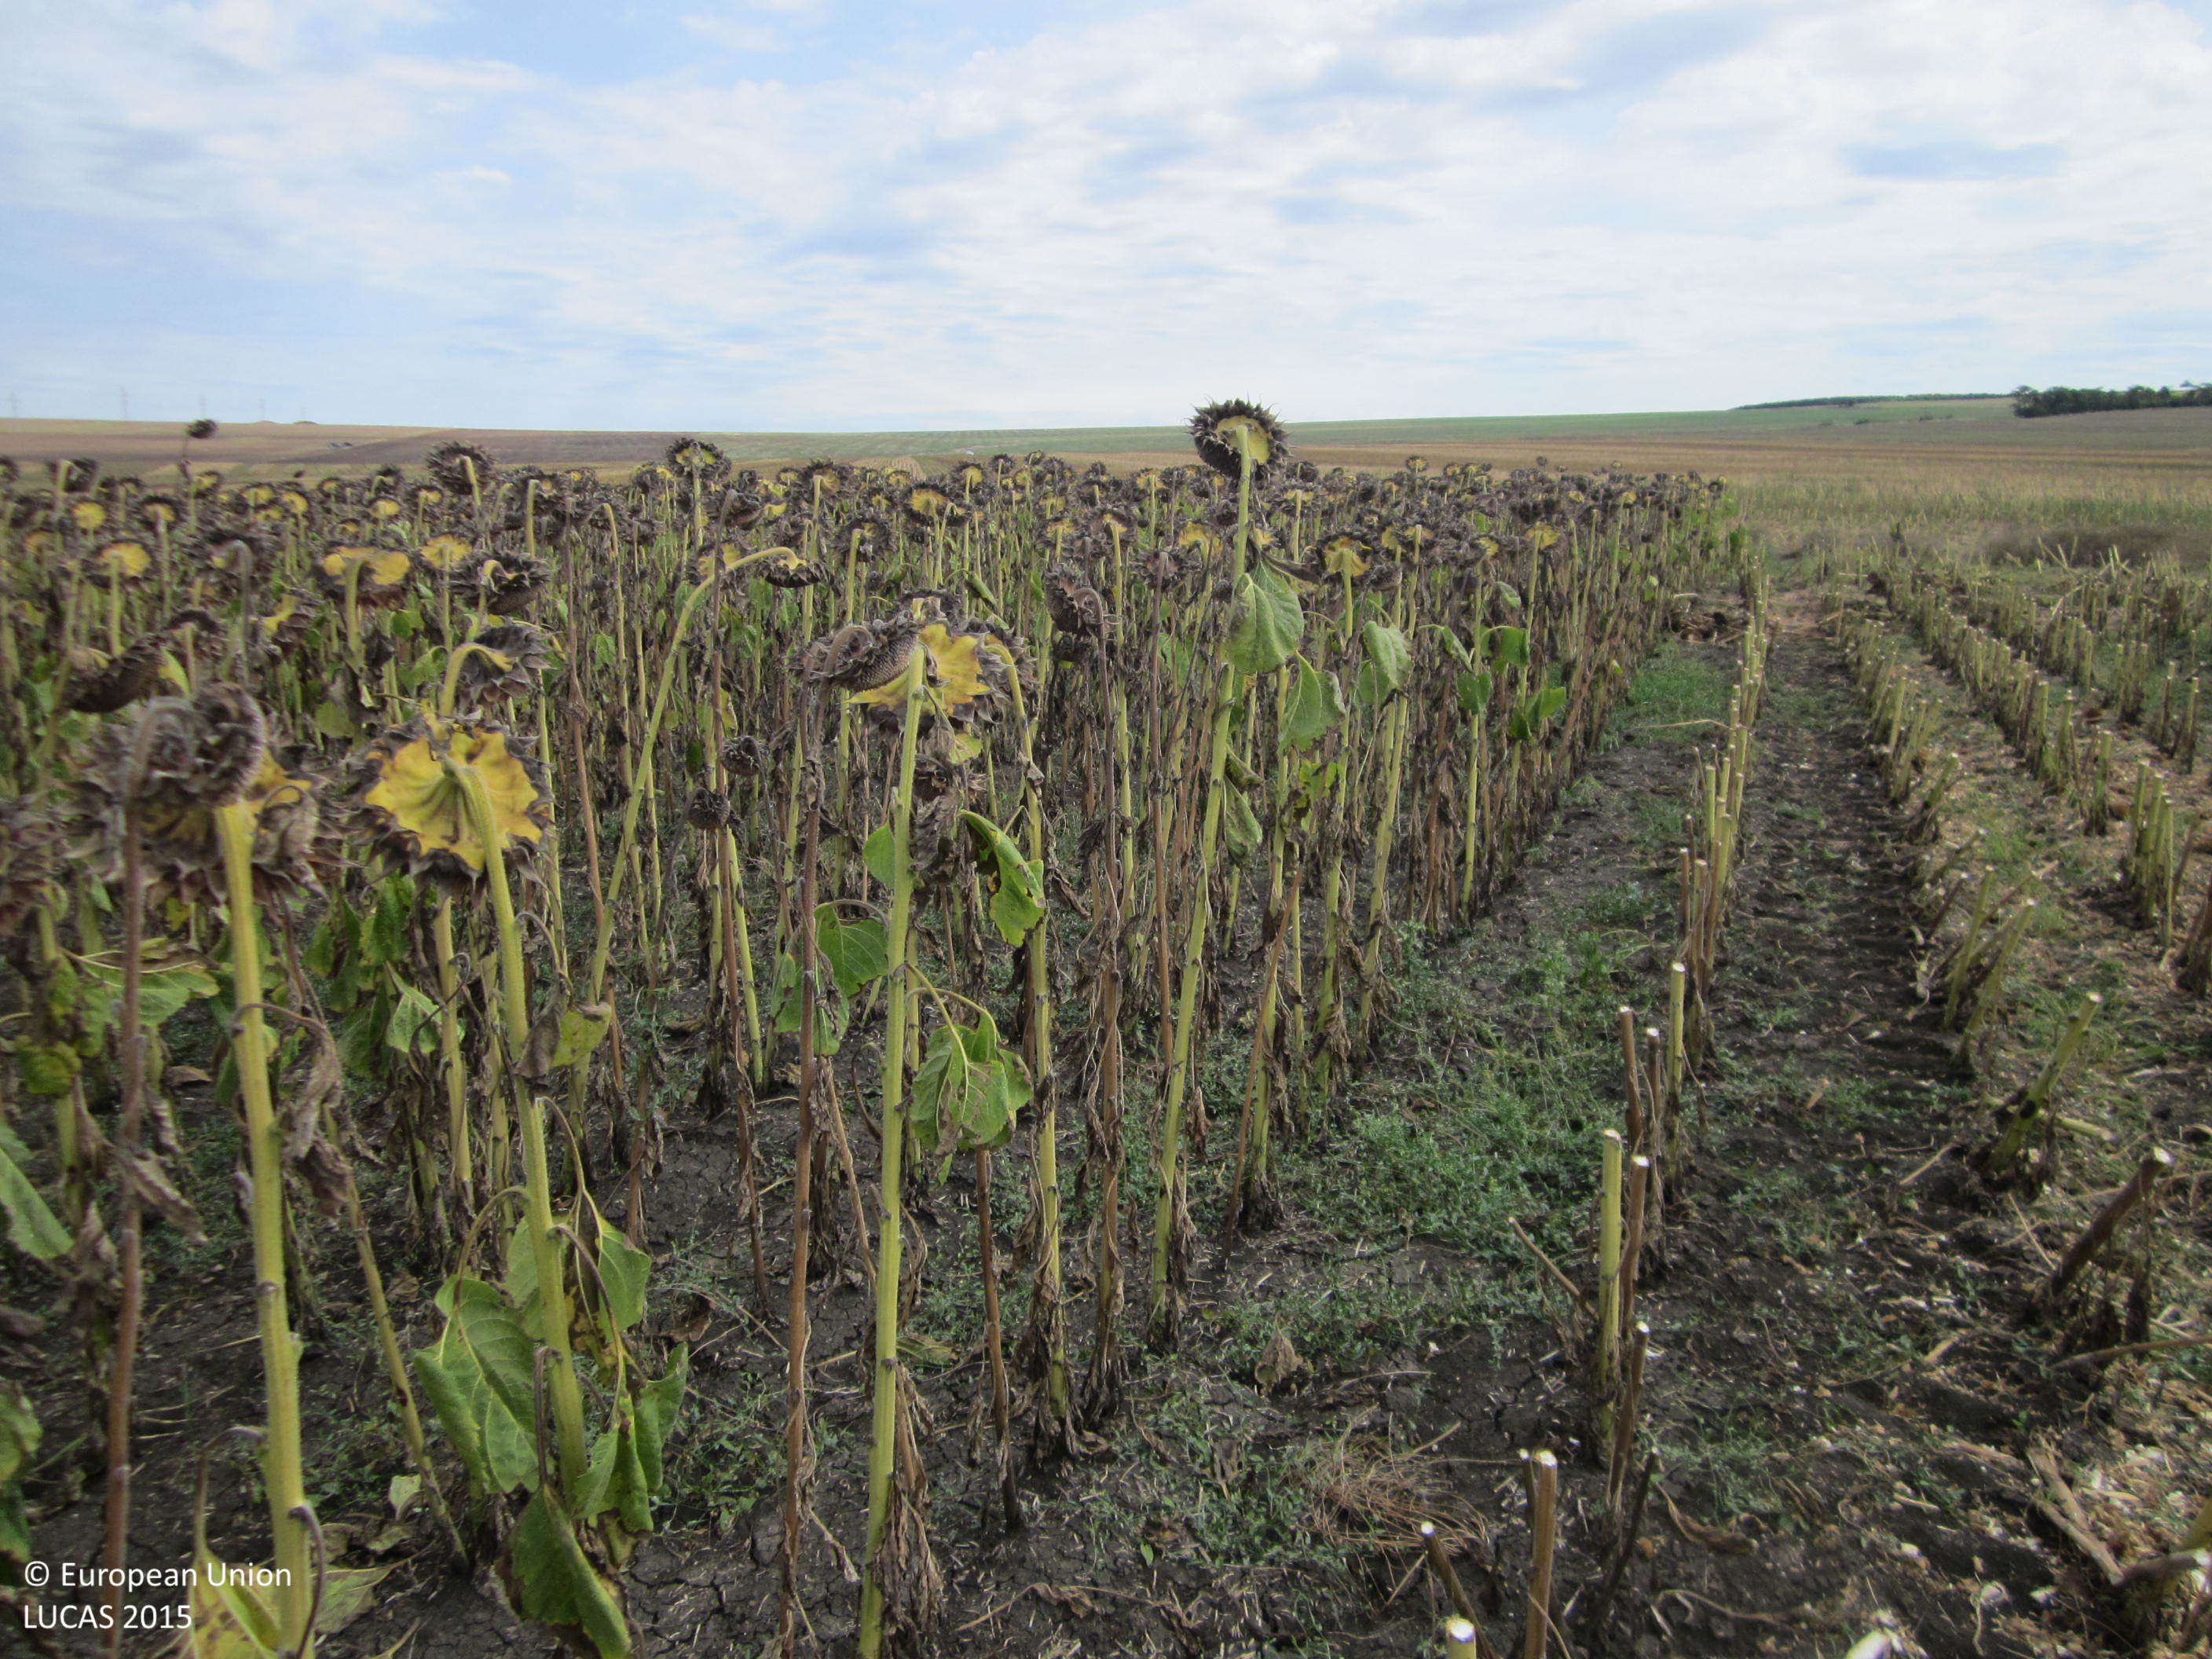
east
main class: Cropland
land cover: Sunflower
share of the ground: > 75 %
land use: Agriculture (excluding fallow land and kitchen gardens)
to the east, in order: Sunflower; Grass margins; Sunflower
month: September
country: BG
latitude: 42.6546
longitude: 27.0269
